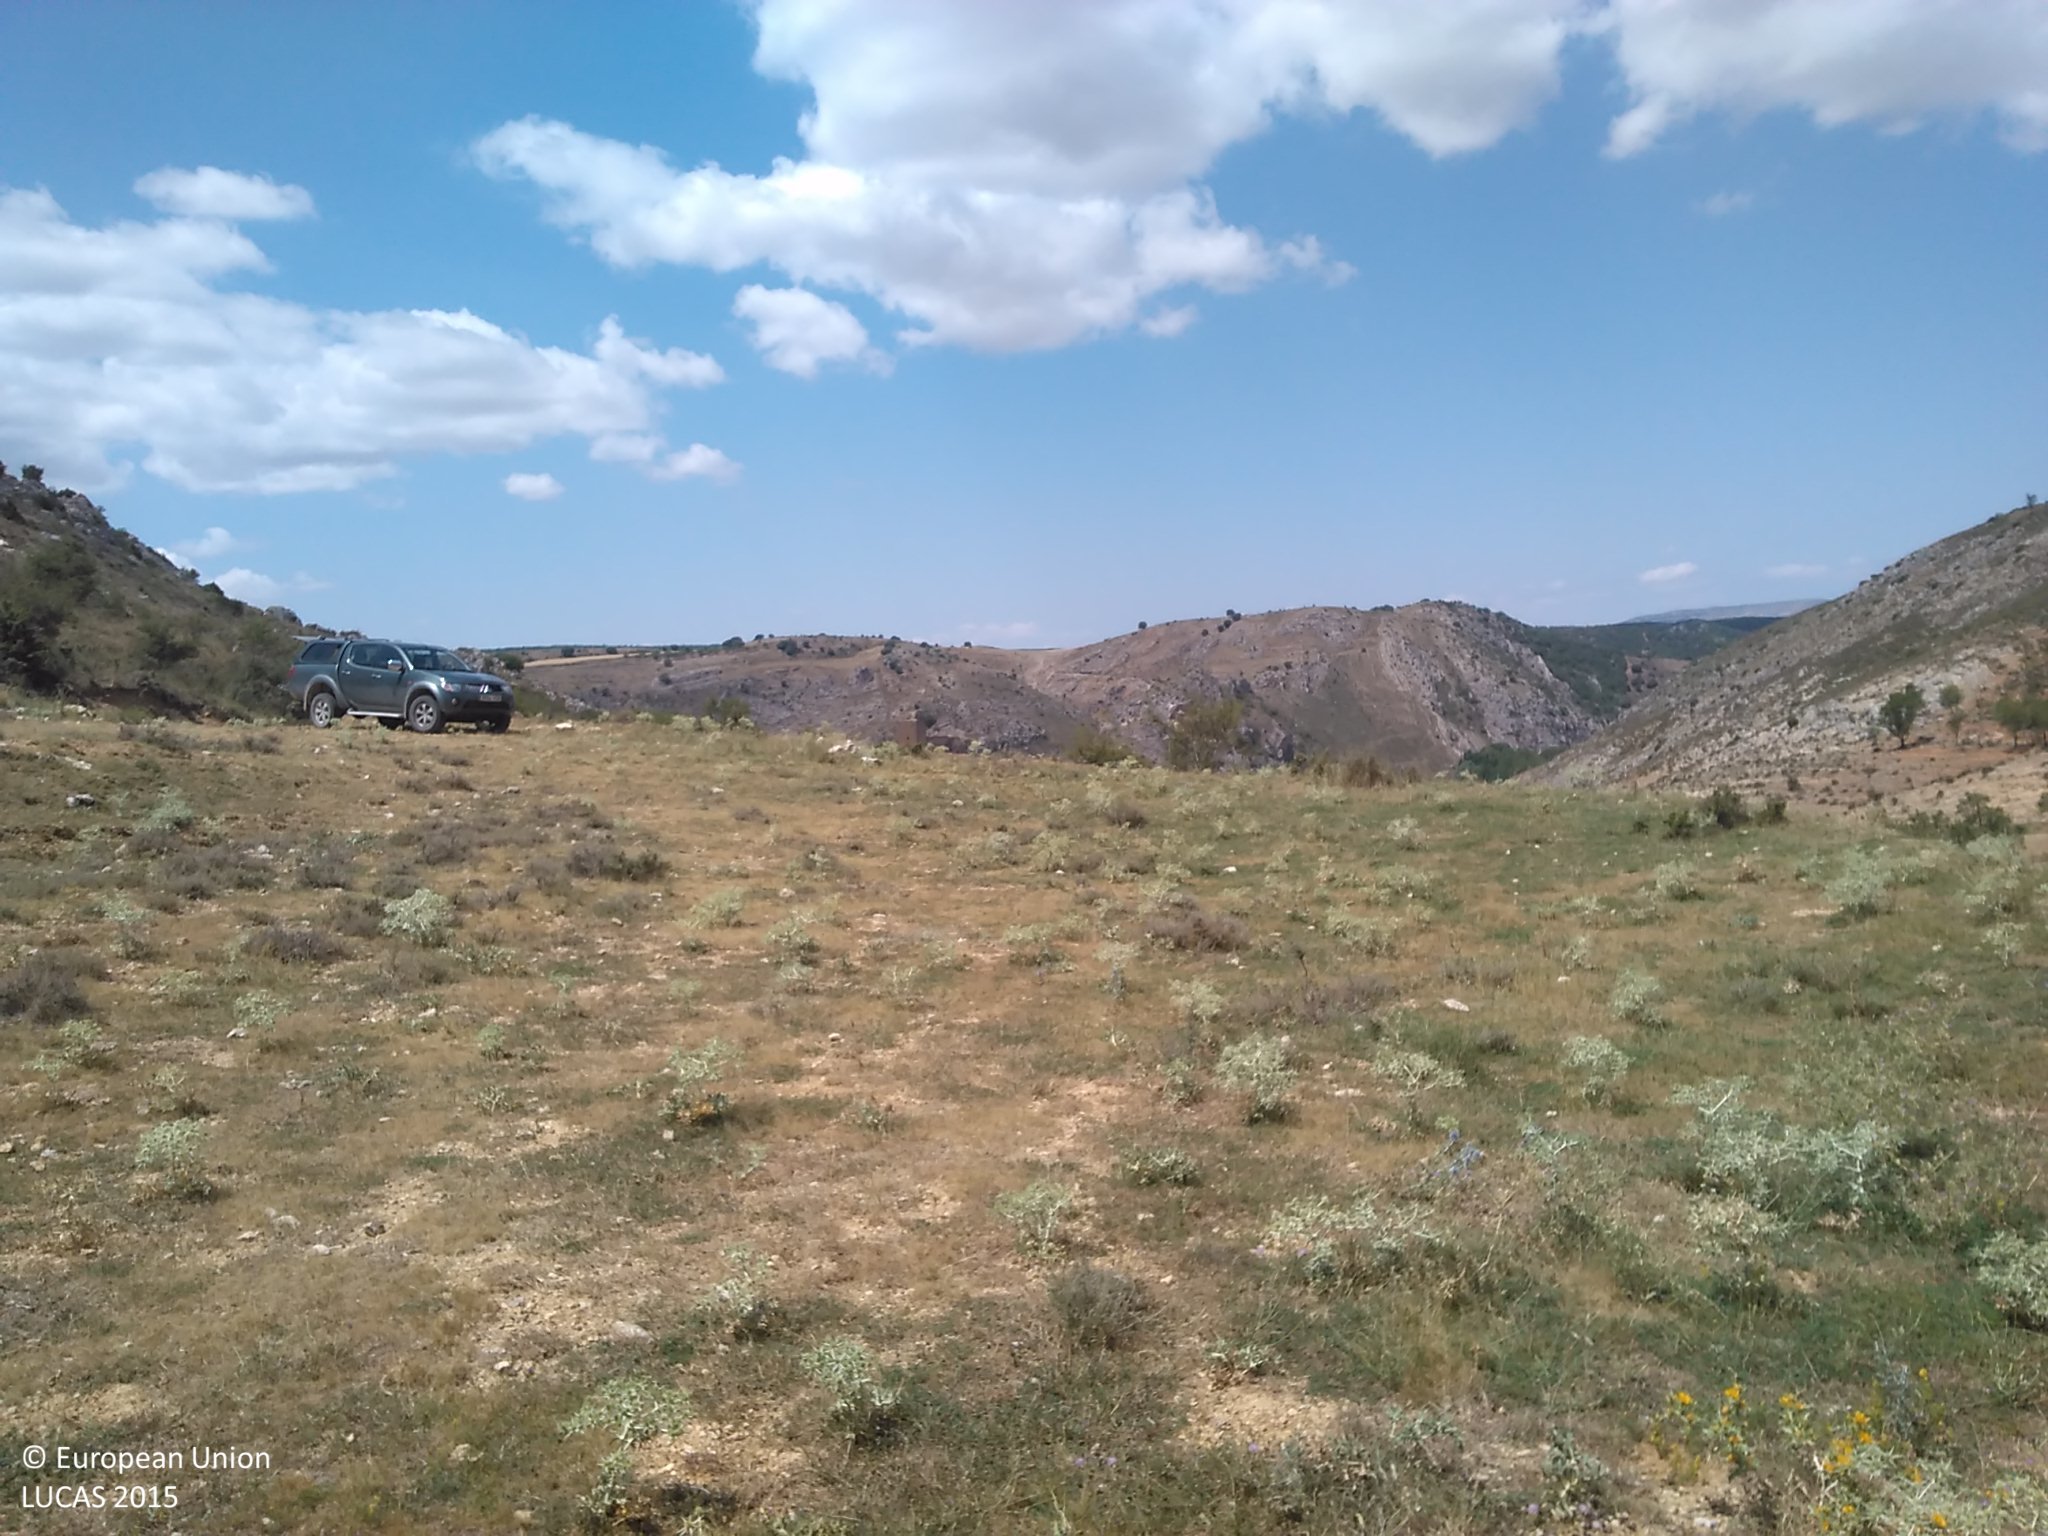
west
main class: Grassland
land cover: Grassland without tree/shrub cover
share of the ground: 50 - 75 %
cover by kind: herbaceous plants 70 %, unconsolidated bare surface 25 %, shrubs 5 %
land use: Agriculture (excluding fallow land and kitchen gardens)
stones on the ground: < 10 %
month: July
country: ES
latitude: 41.5623
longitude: -1.9372
